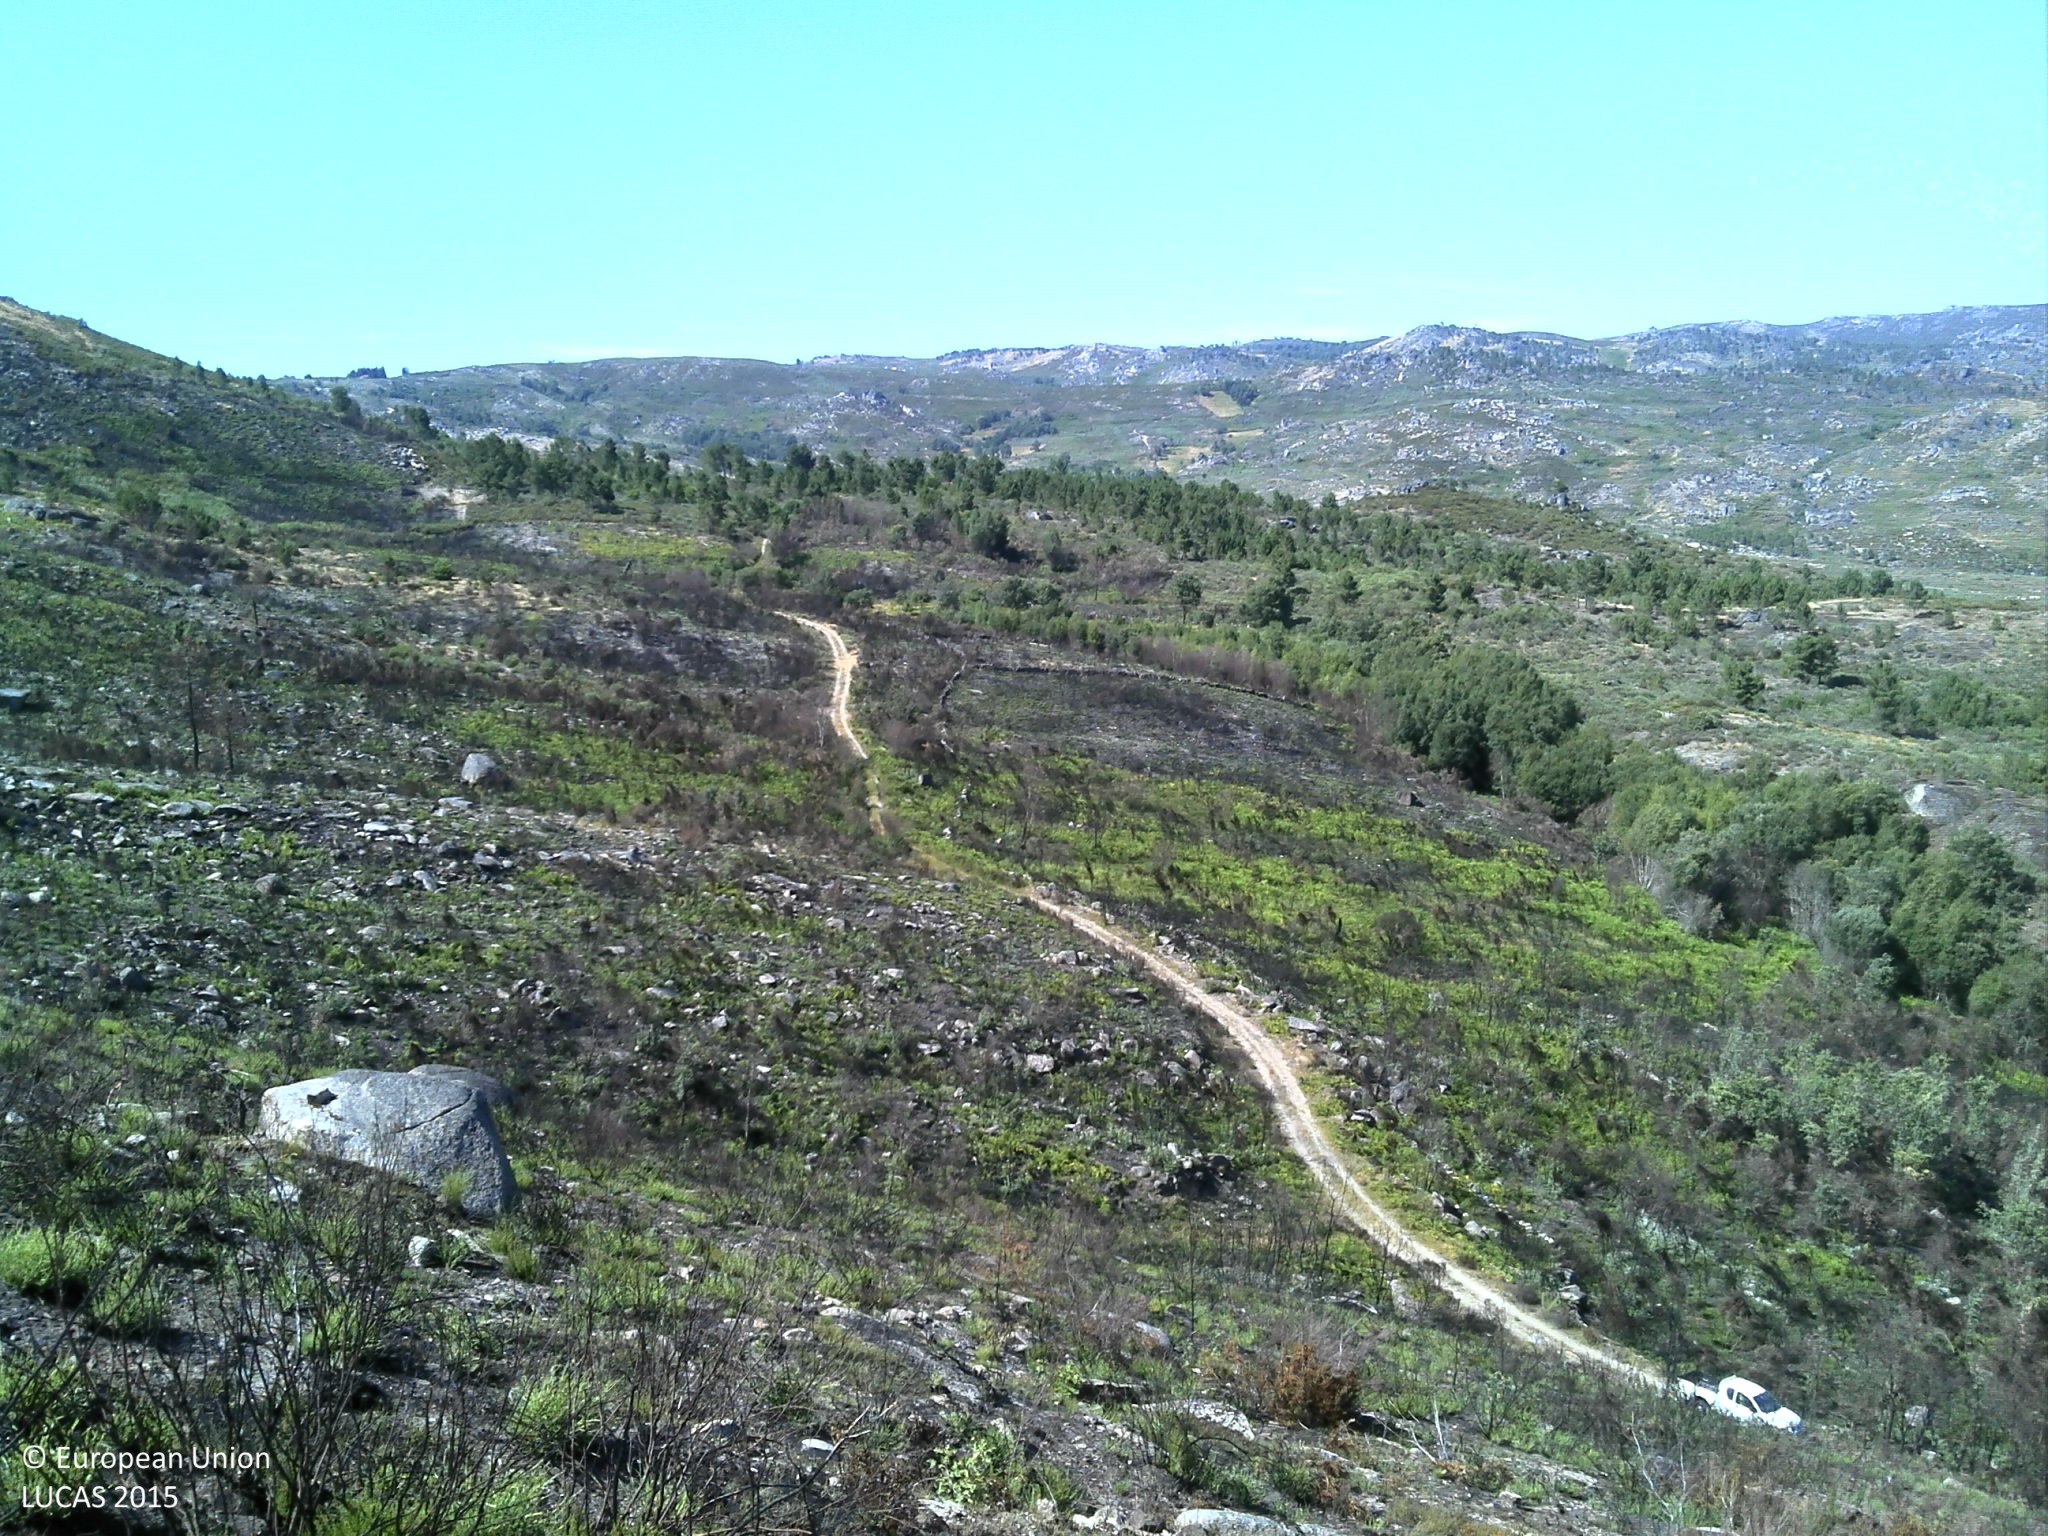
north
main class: Shrubland
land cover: Shrubland without tree cover
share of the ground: 25 - 50 %
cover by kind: unconsolidated bare surface 60 %, shrubs 30 %, herbaceous plants 5 %, consolidated bare surface 5 %
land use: Semi-natural and natural areas not in use
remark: Burnt area
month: July
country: PT
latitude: 41.7563
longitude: -7.6341
